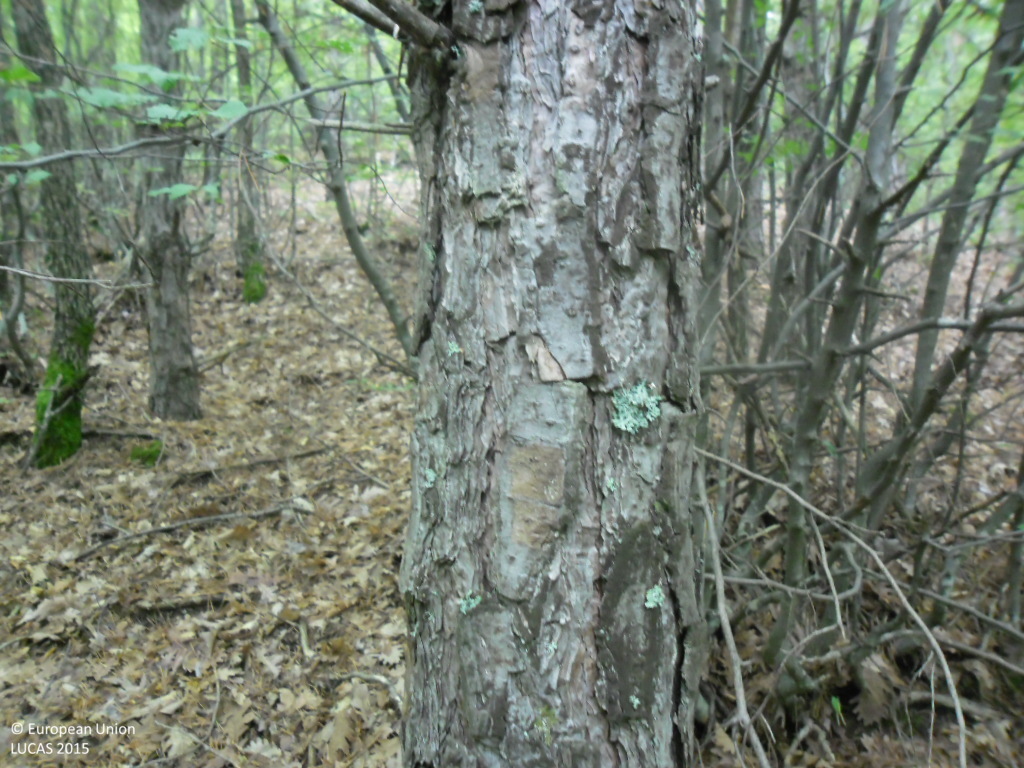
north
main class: Woodland
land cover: Pine dominated mixed woodland
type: hemiboreal forest and nemoral coniferous forest and mixed broadleaved-coniferous forest
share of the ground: > 75 %
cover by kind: coniferous forest trees 75 %, broadleaved forest trees 25 %
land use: Forestry
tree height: > 5 m
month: September
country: BG
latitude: 41.6147
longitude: 23.1129
